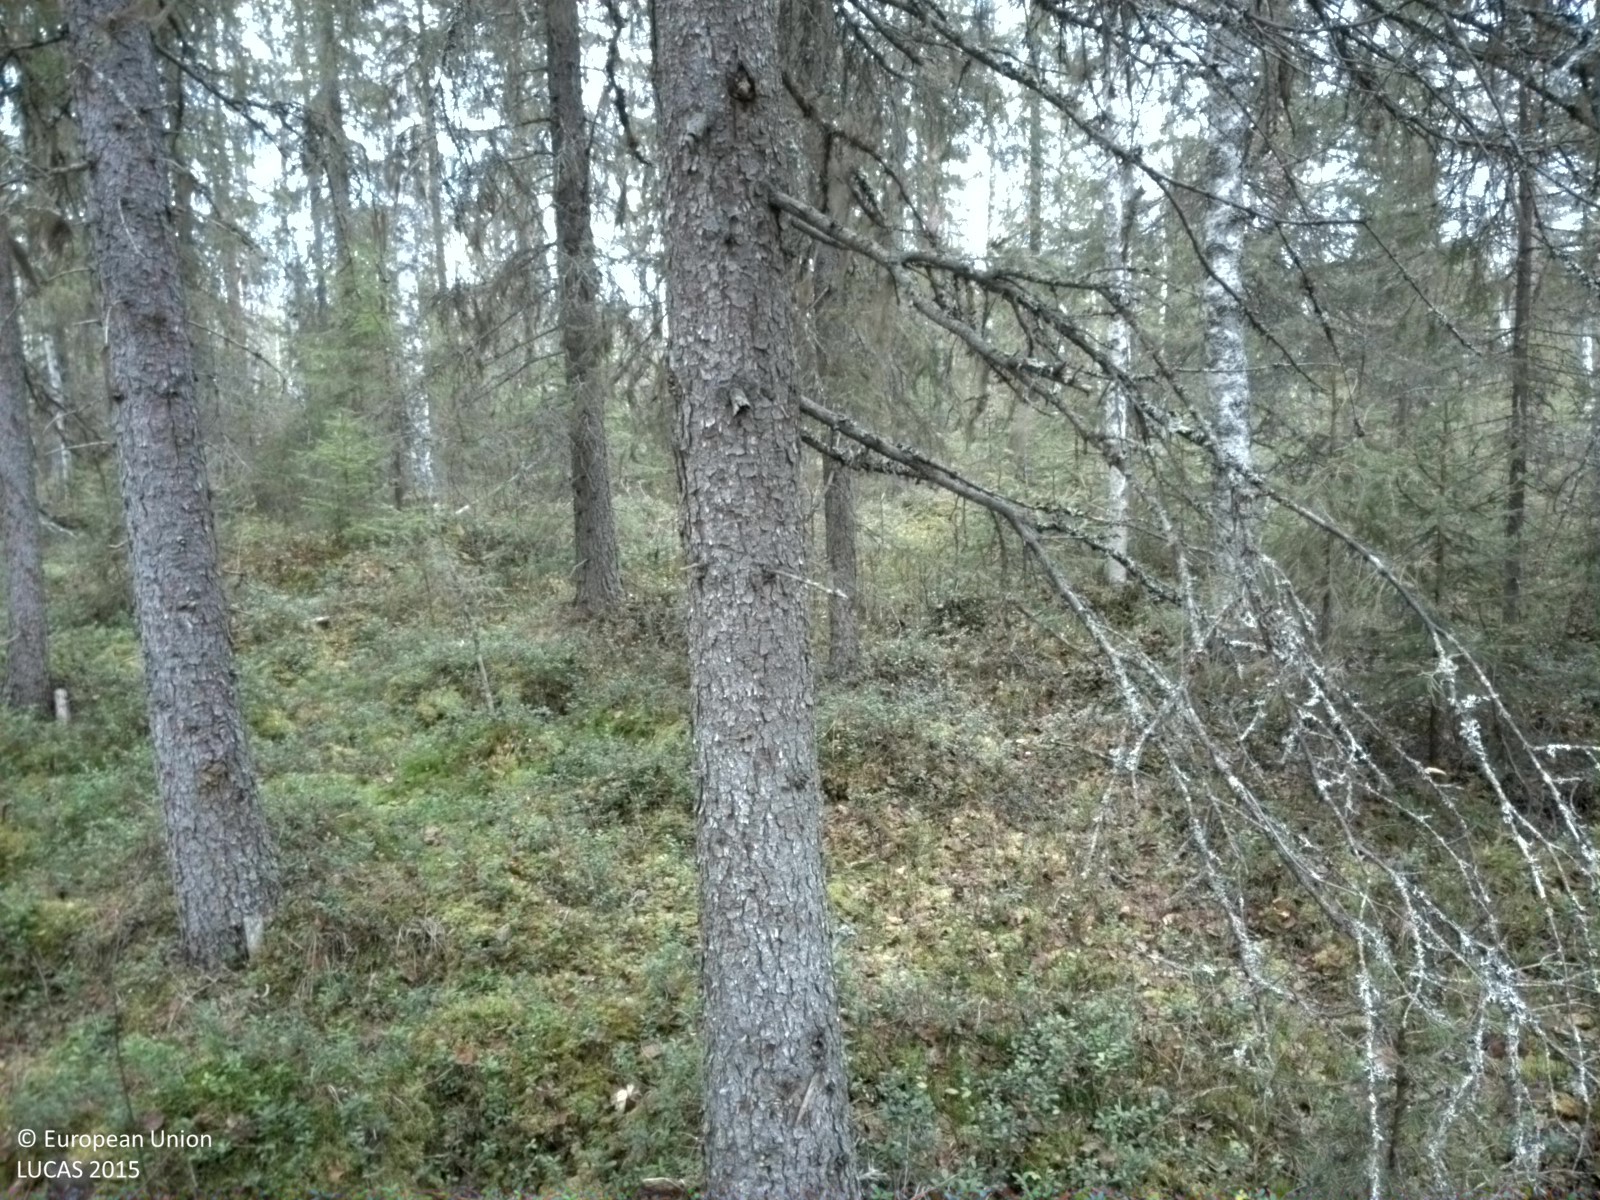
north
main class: Woodland
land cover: Spruce dominated mixed woodland
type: boreal forest
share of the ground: 50 - 75 %
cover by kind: coniferous forest trees 40 %, shrubs 40 %, broadleaved forest trees 15 %, lichens and mosses 5 %
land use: Forestry
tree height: > 5 m
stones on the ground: < 10 %
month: October
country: SE
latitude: 65.6577
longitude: 21.0358
